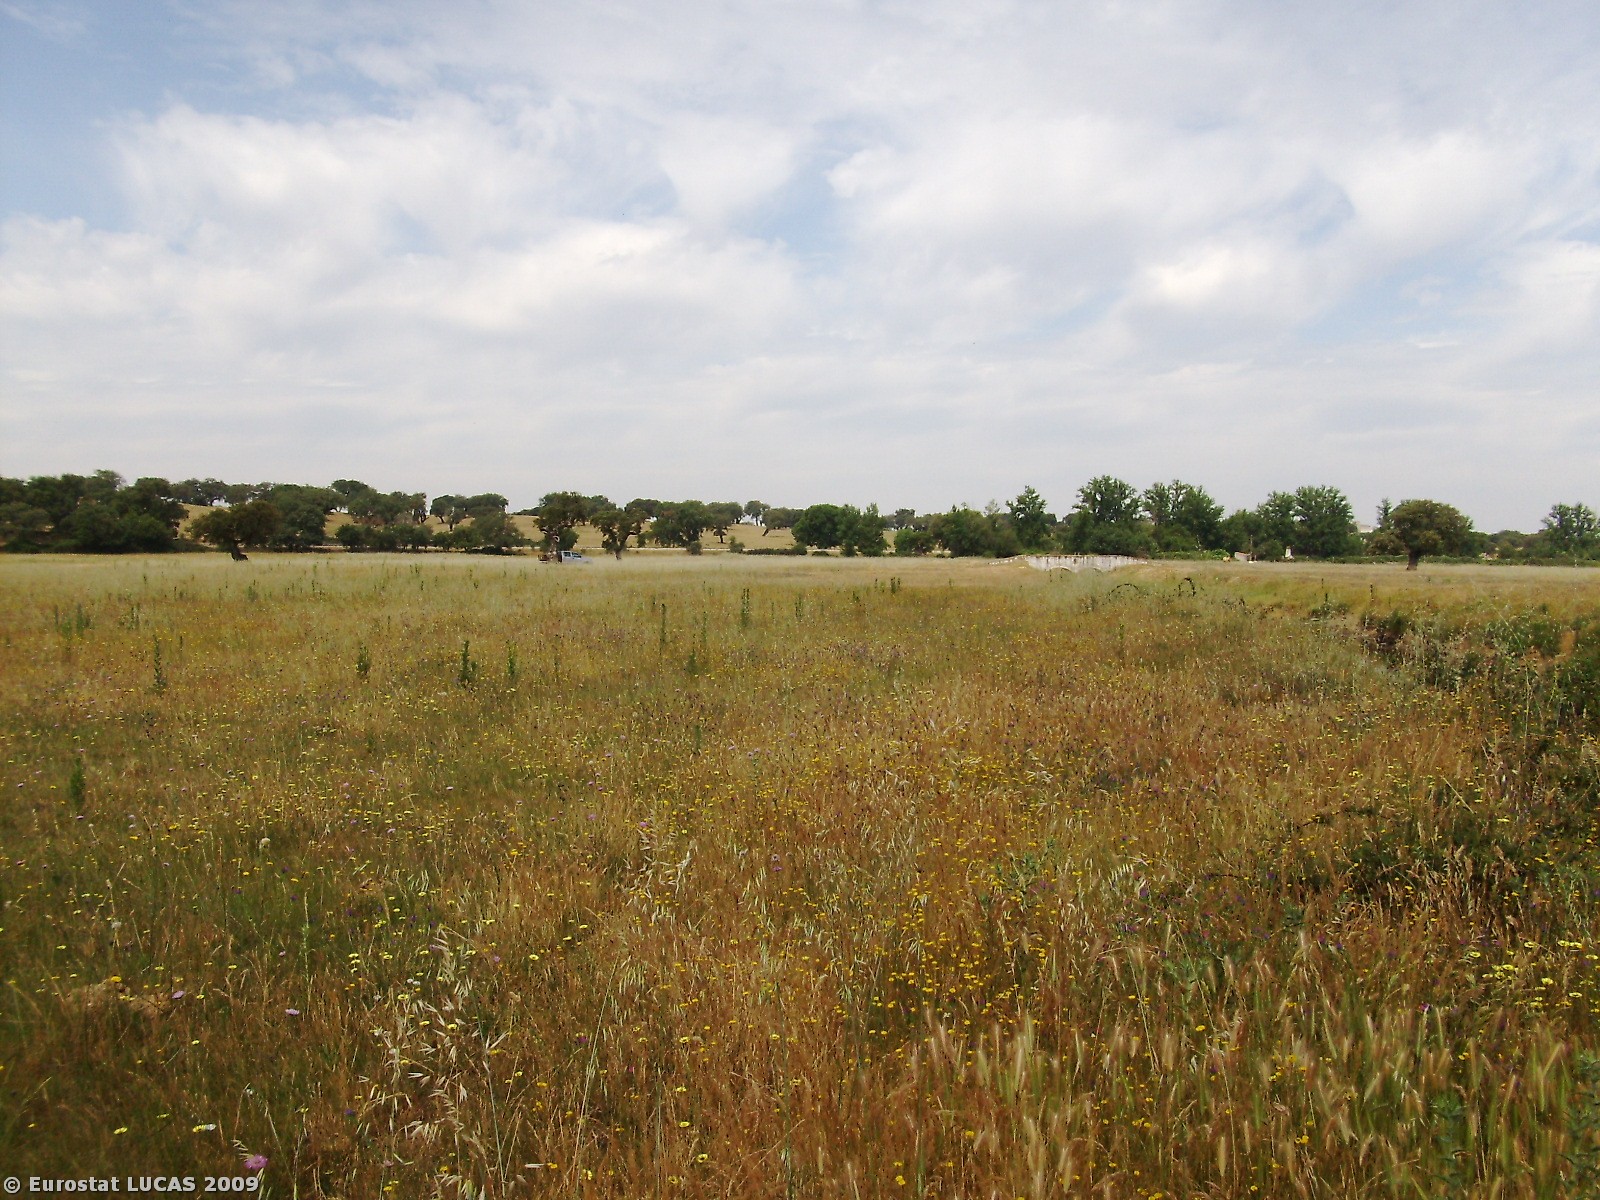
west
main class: Grassland
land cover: Grassland with sparse tree/shrub cover
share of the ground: > 75 %
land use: Agriculture (excluding fallow land and kitchen gardens)
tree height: > 5 m
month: June
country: PT
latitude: 39.1899
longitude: -7.4411
